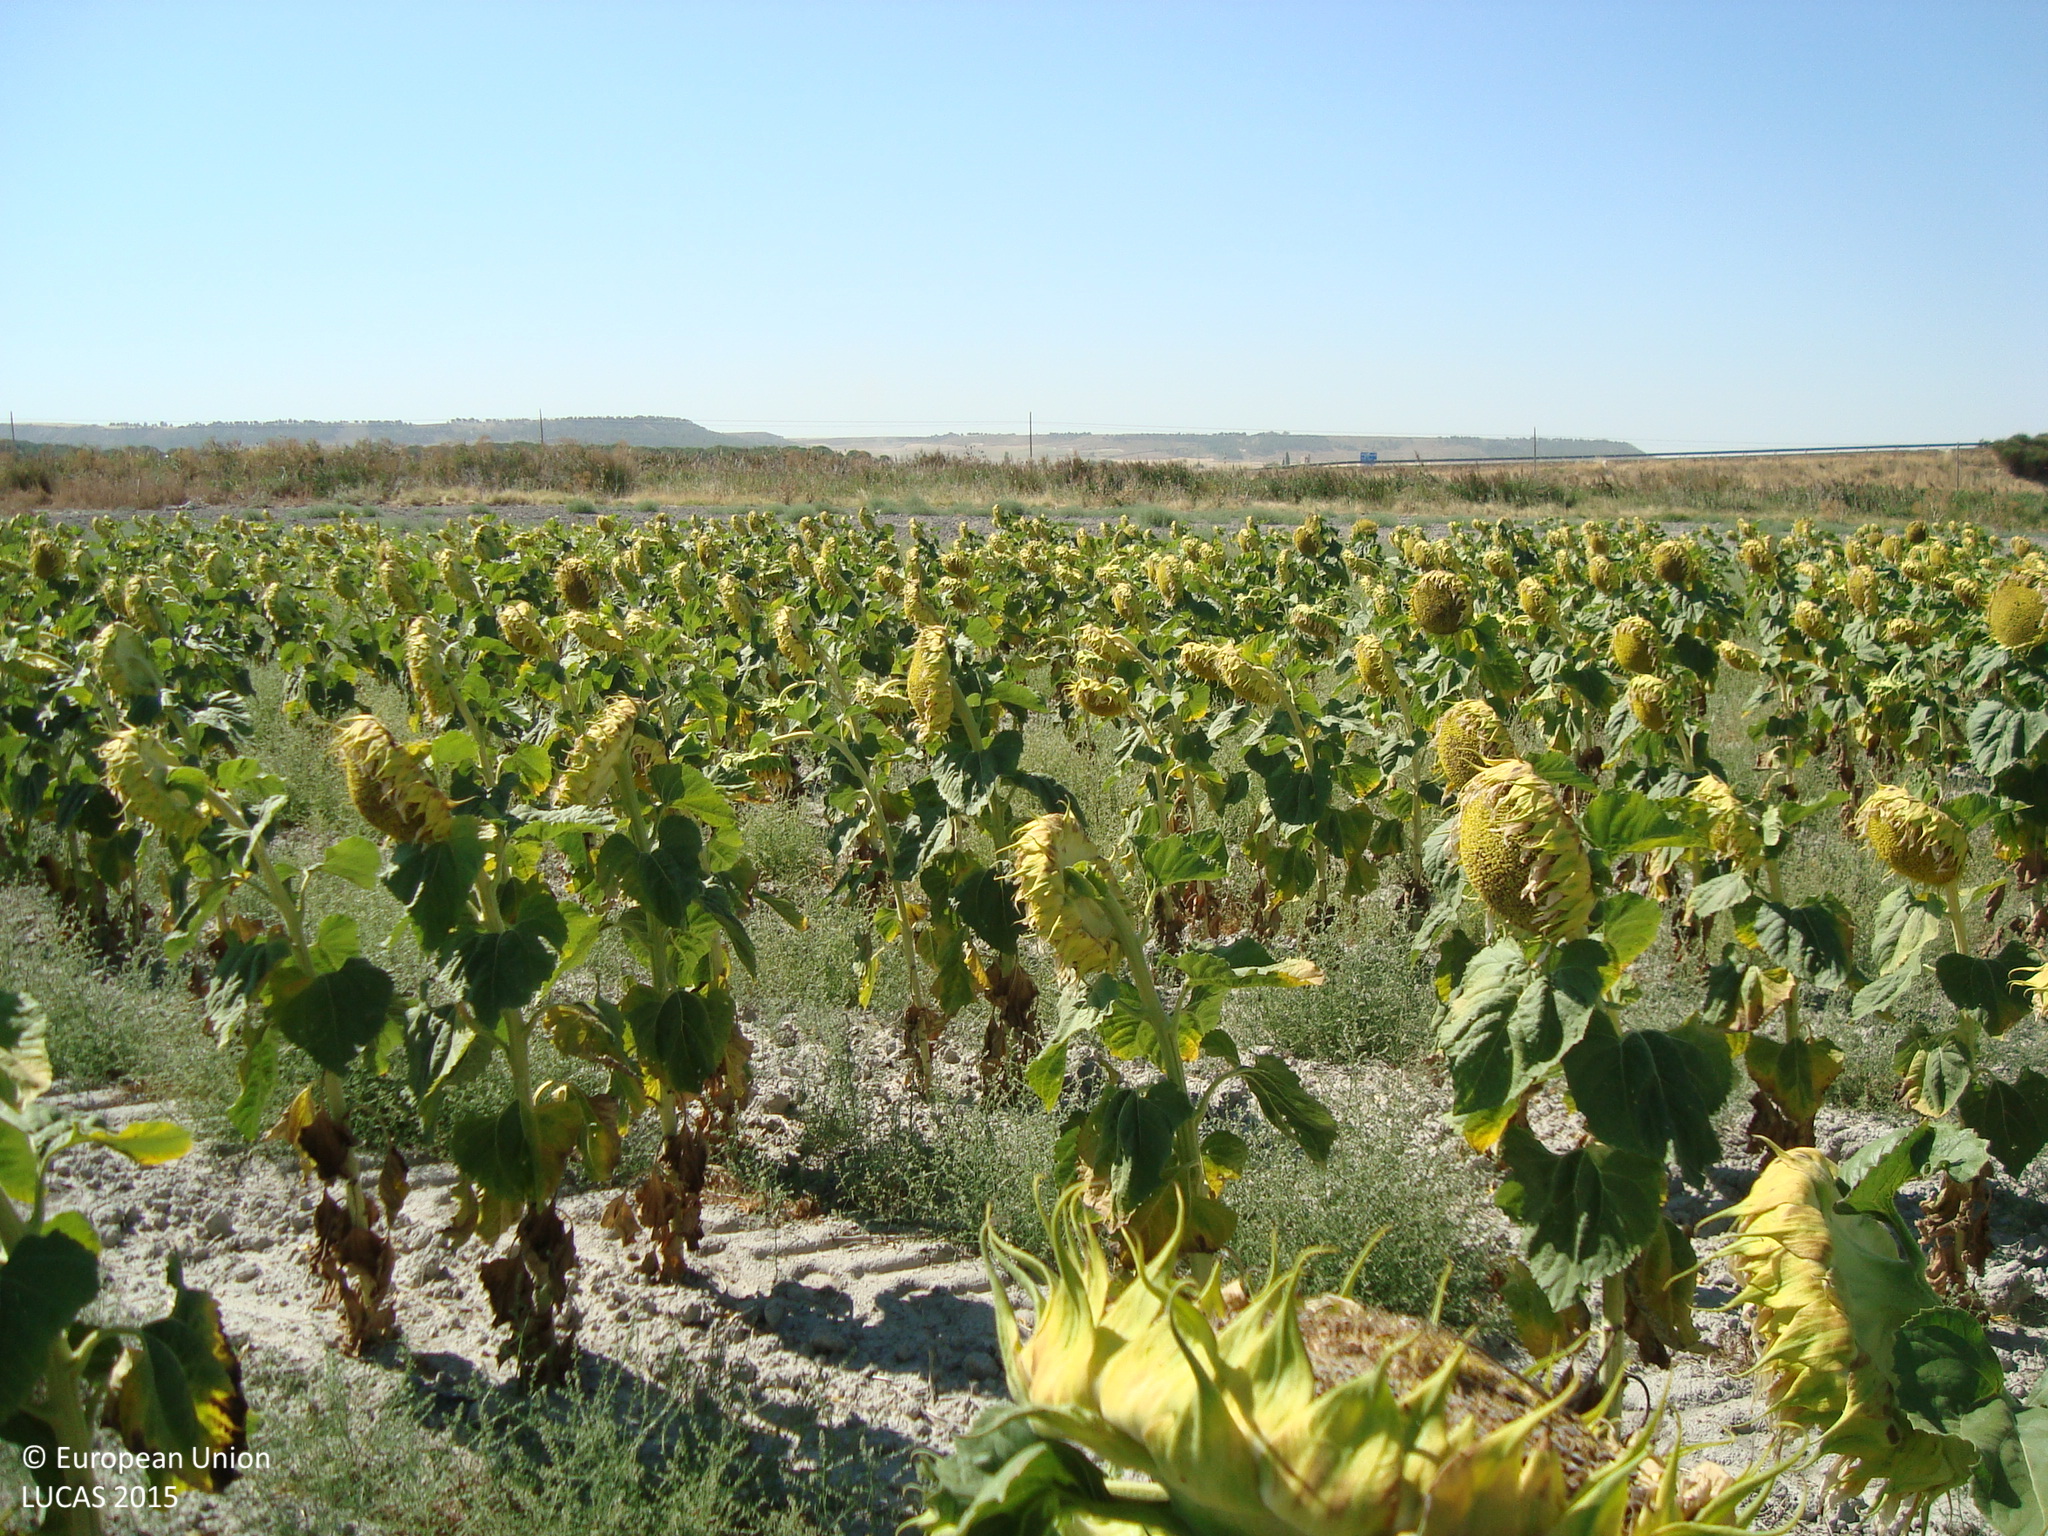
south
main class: Cropland
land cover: Sunflower
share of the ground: > 75 %
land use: Agriculture (excluding fallow land and kitchen gardens)
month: August
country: ES
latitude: 41.4774
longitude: -4.6150
